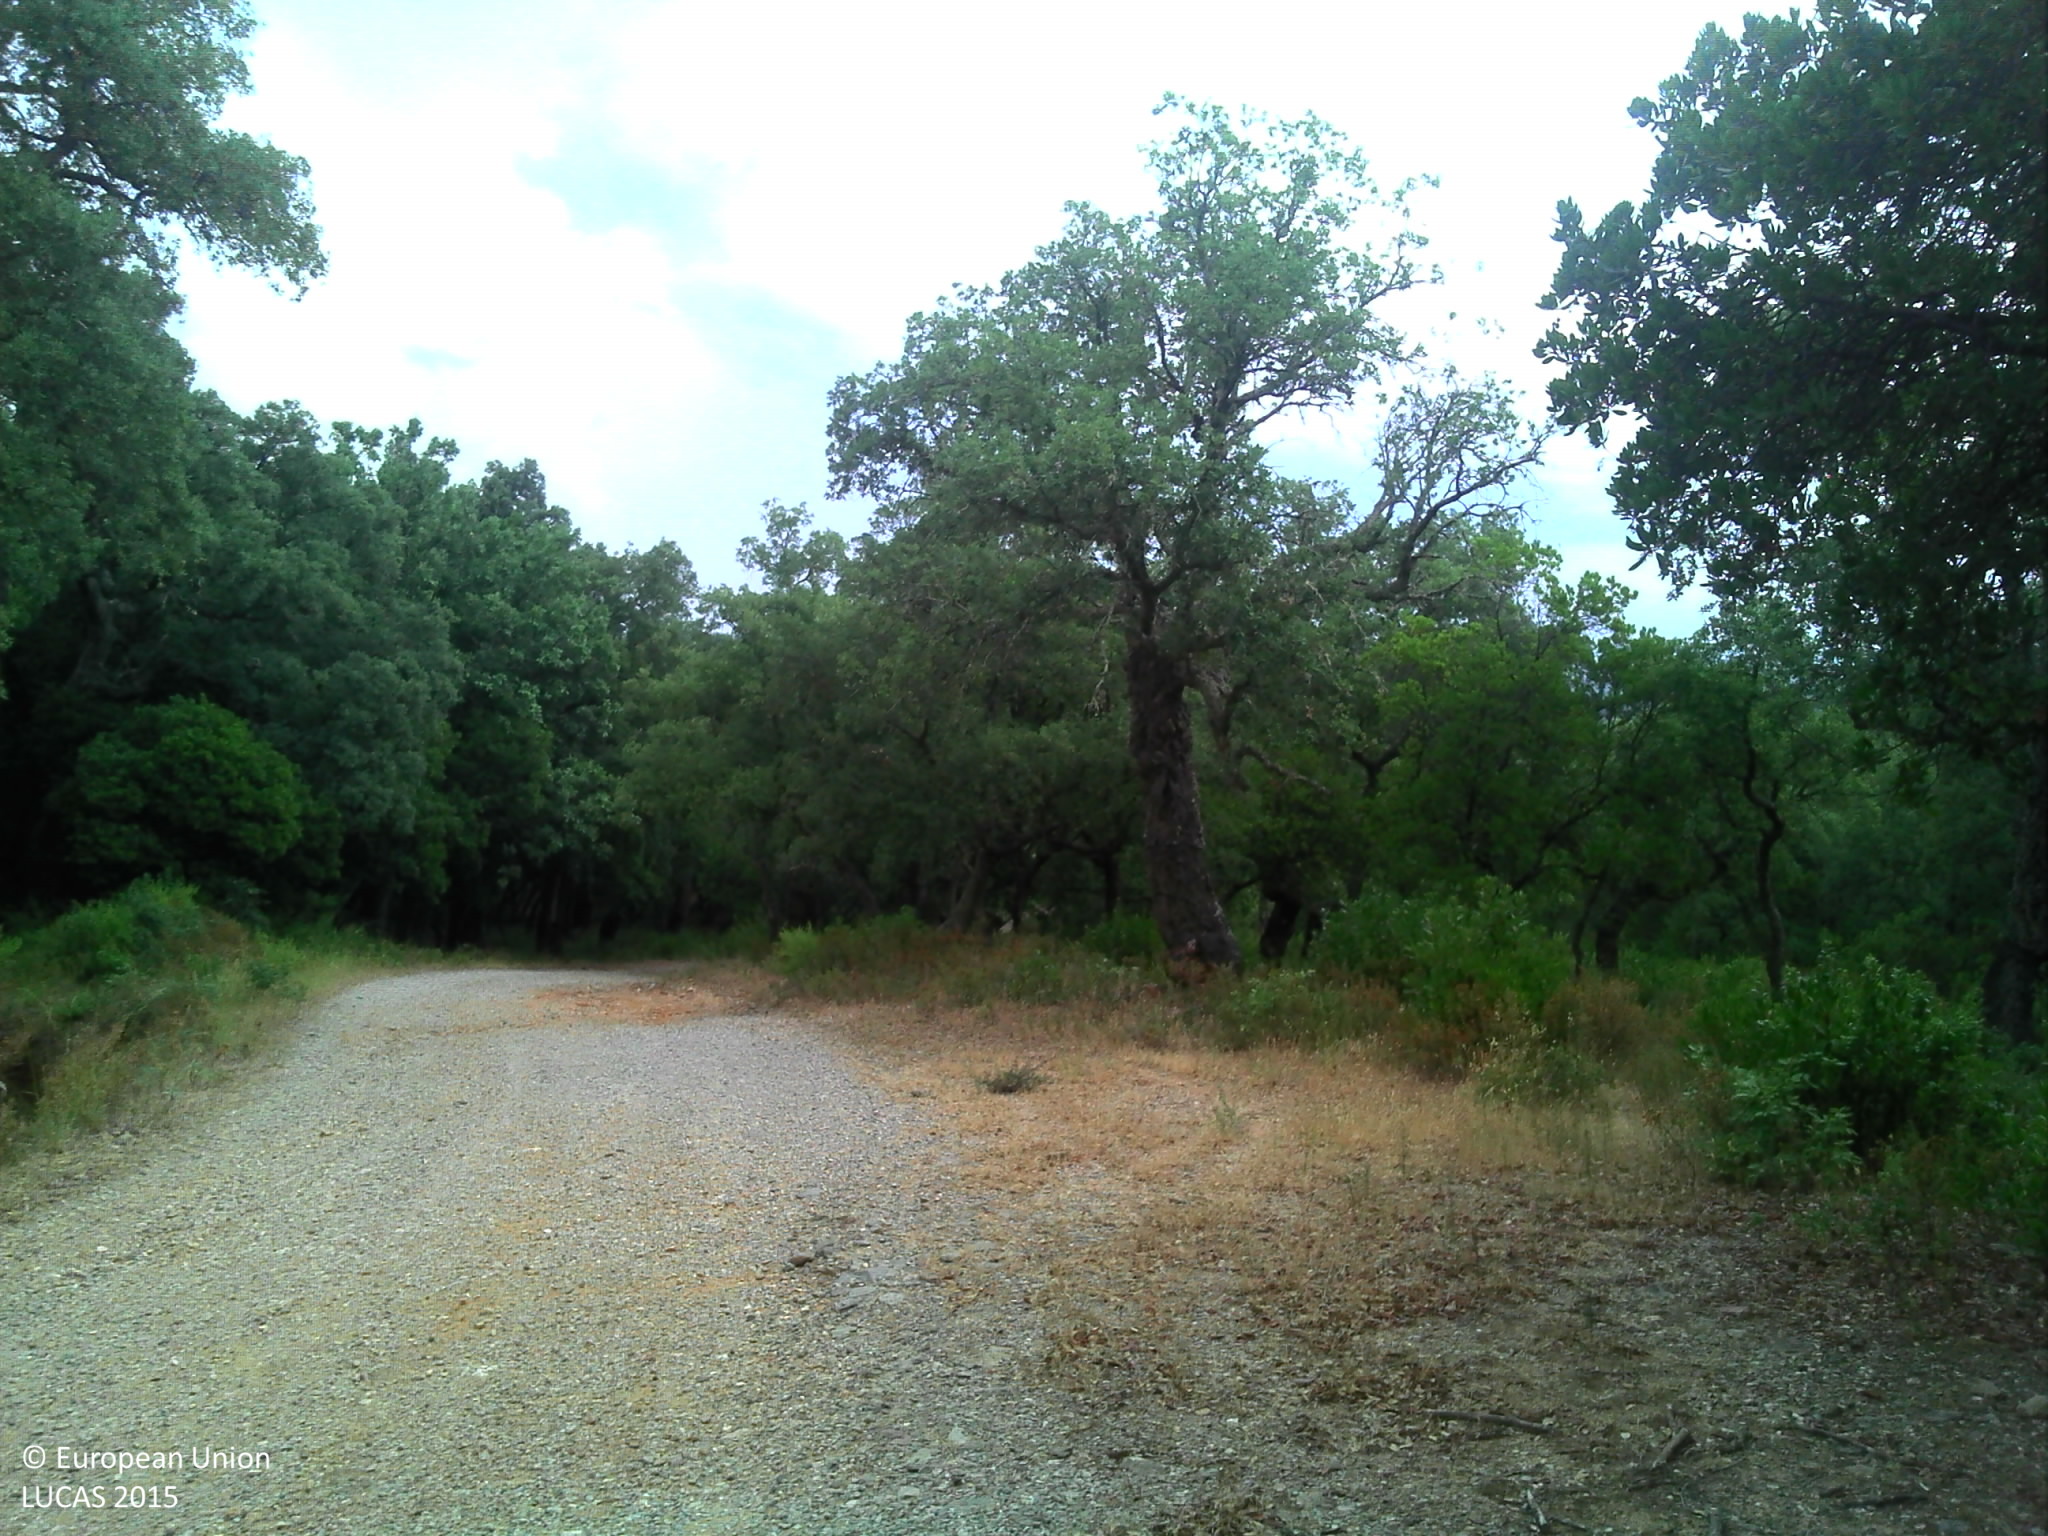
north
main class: Woodland
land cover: Broadleaved woodland
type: thermophilous deciduous forest
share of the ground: > 75 %
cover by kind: broadleaved forest trees 90 %, shrubs 10 %
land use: Forestry
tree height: > 5 m
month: July
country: FR
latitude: 43.3128
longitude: 6.3965
